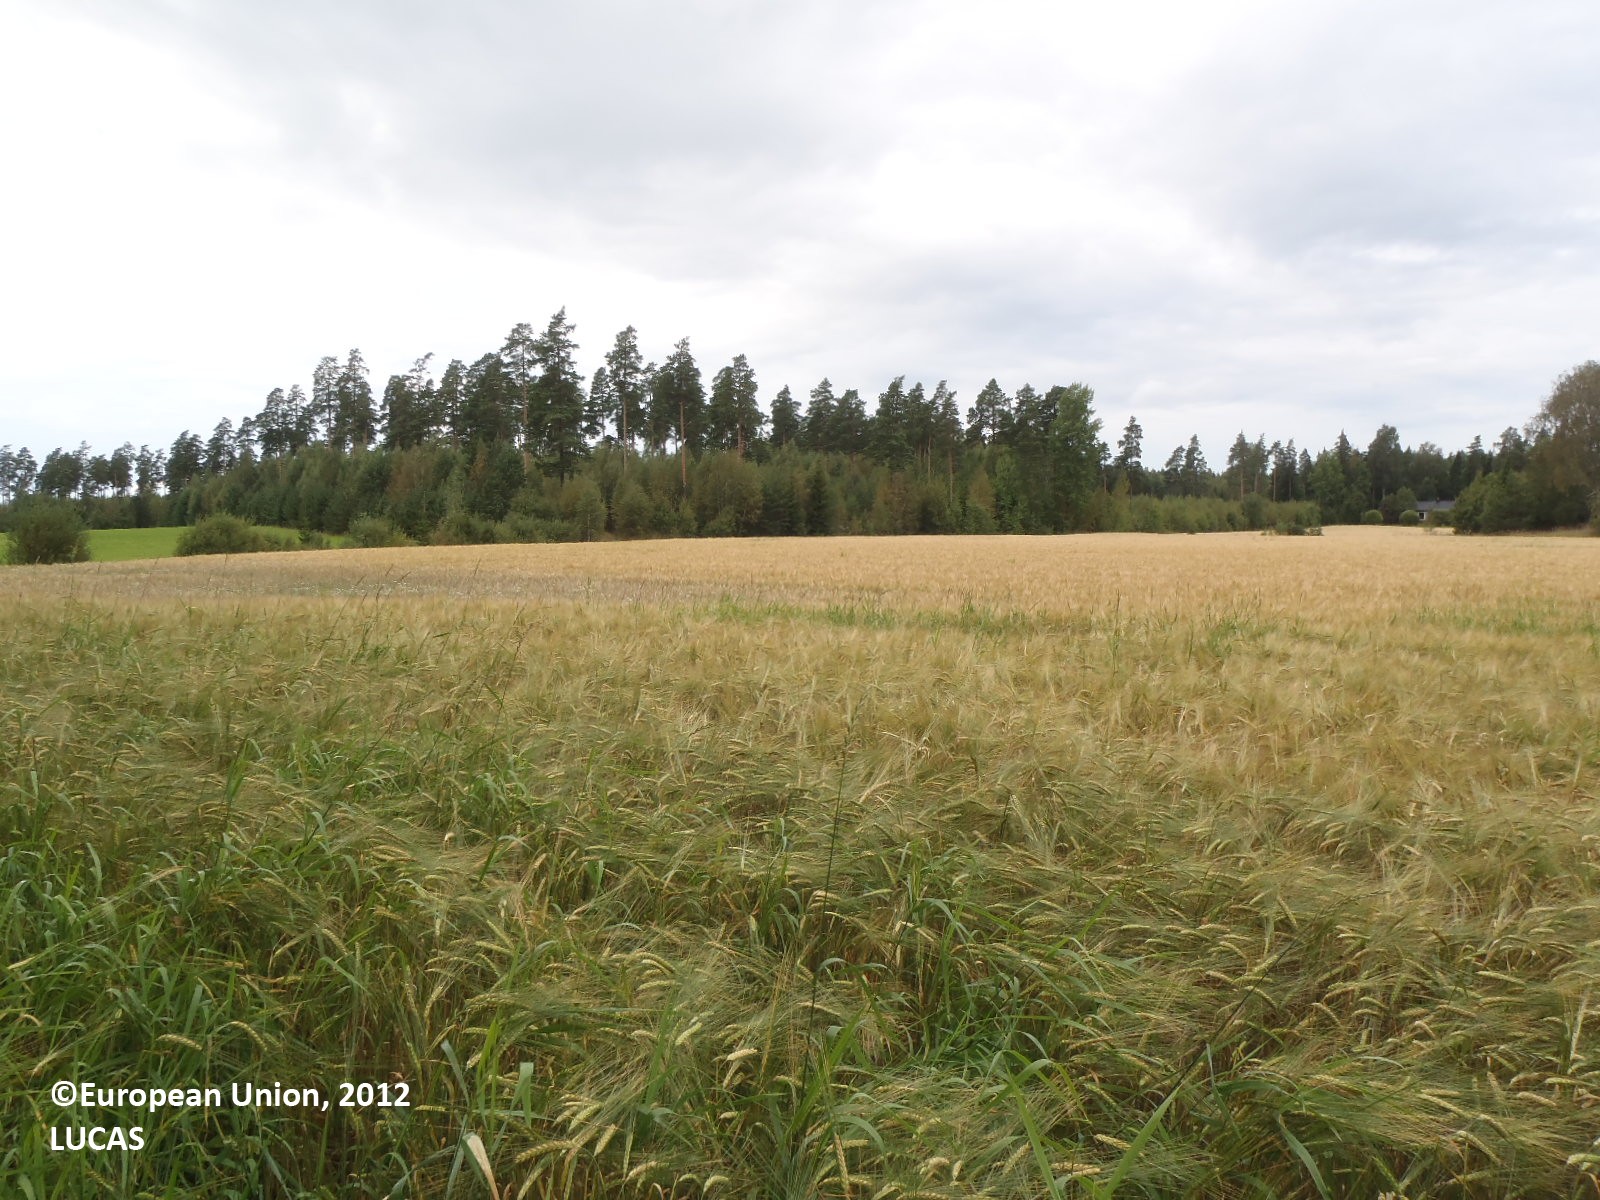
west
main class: Cropland
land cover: Barley
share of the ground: > 75 %
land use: Agriculture (excluding fallow land and kitchen gardens)
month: August
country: FI
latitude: 60.5555
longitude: 22.2668
